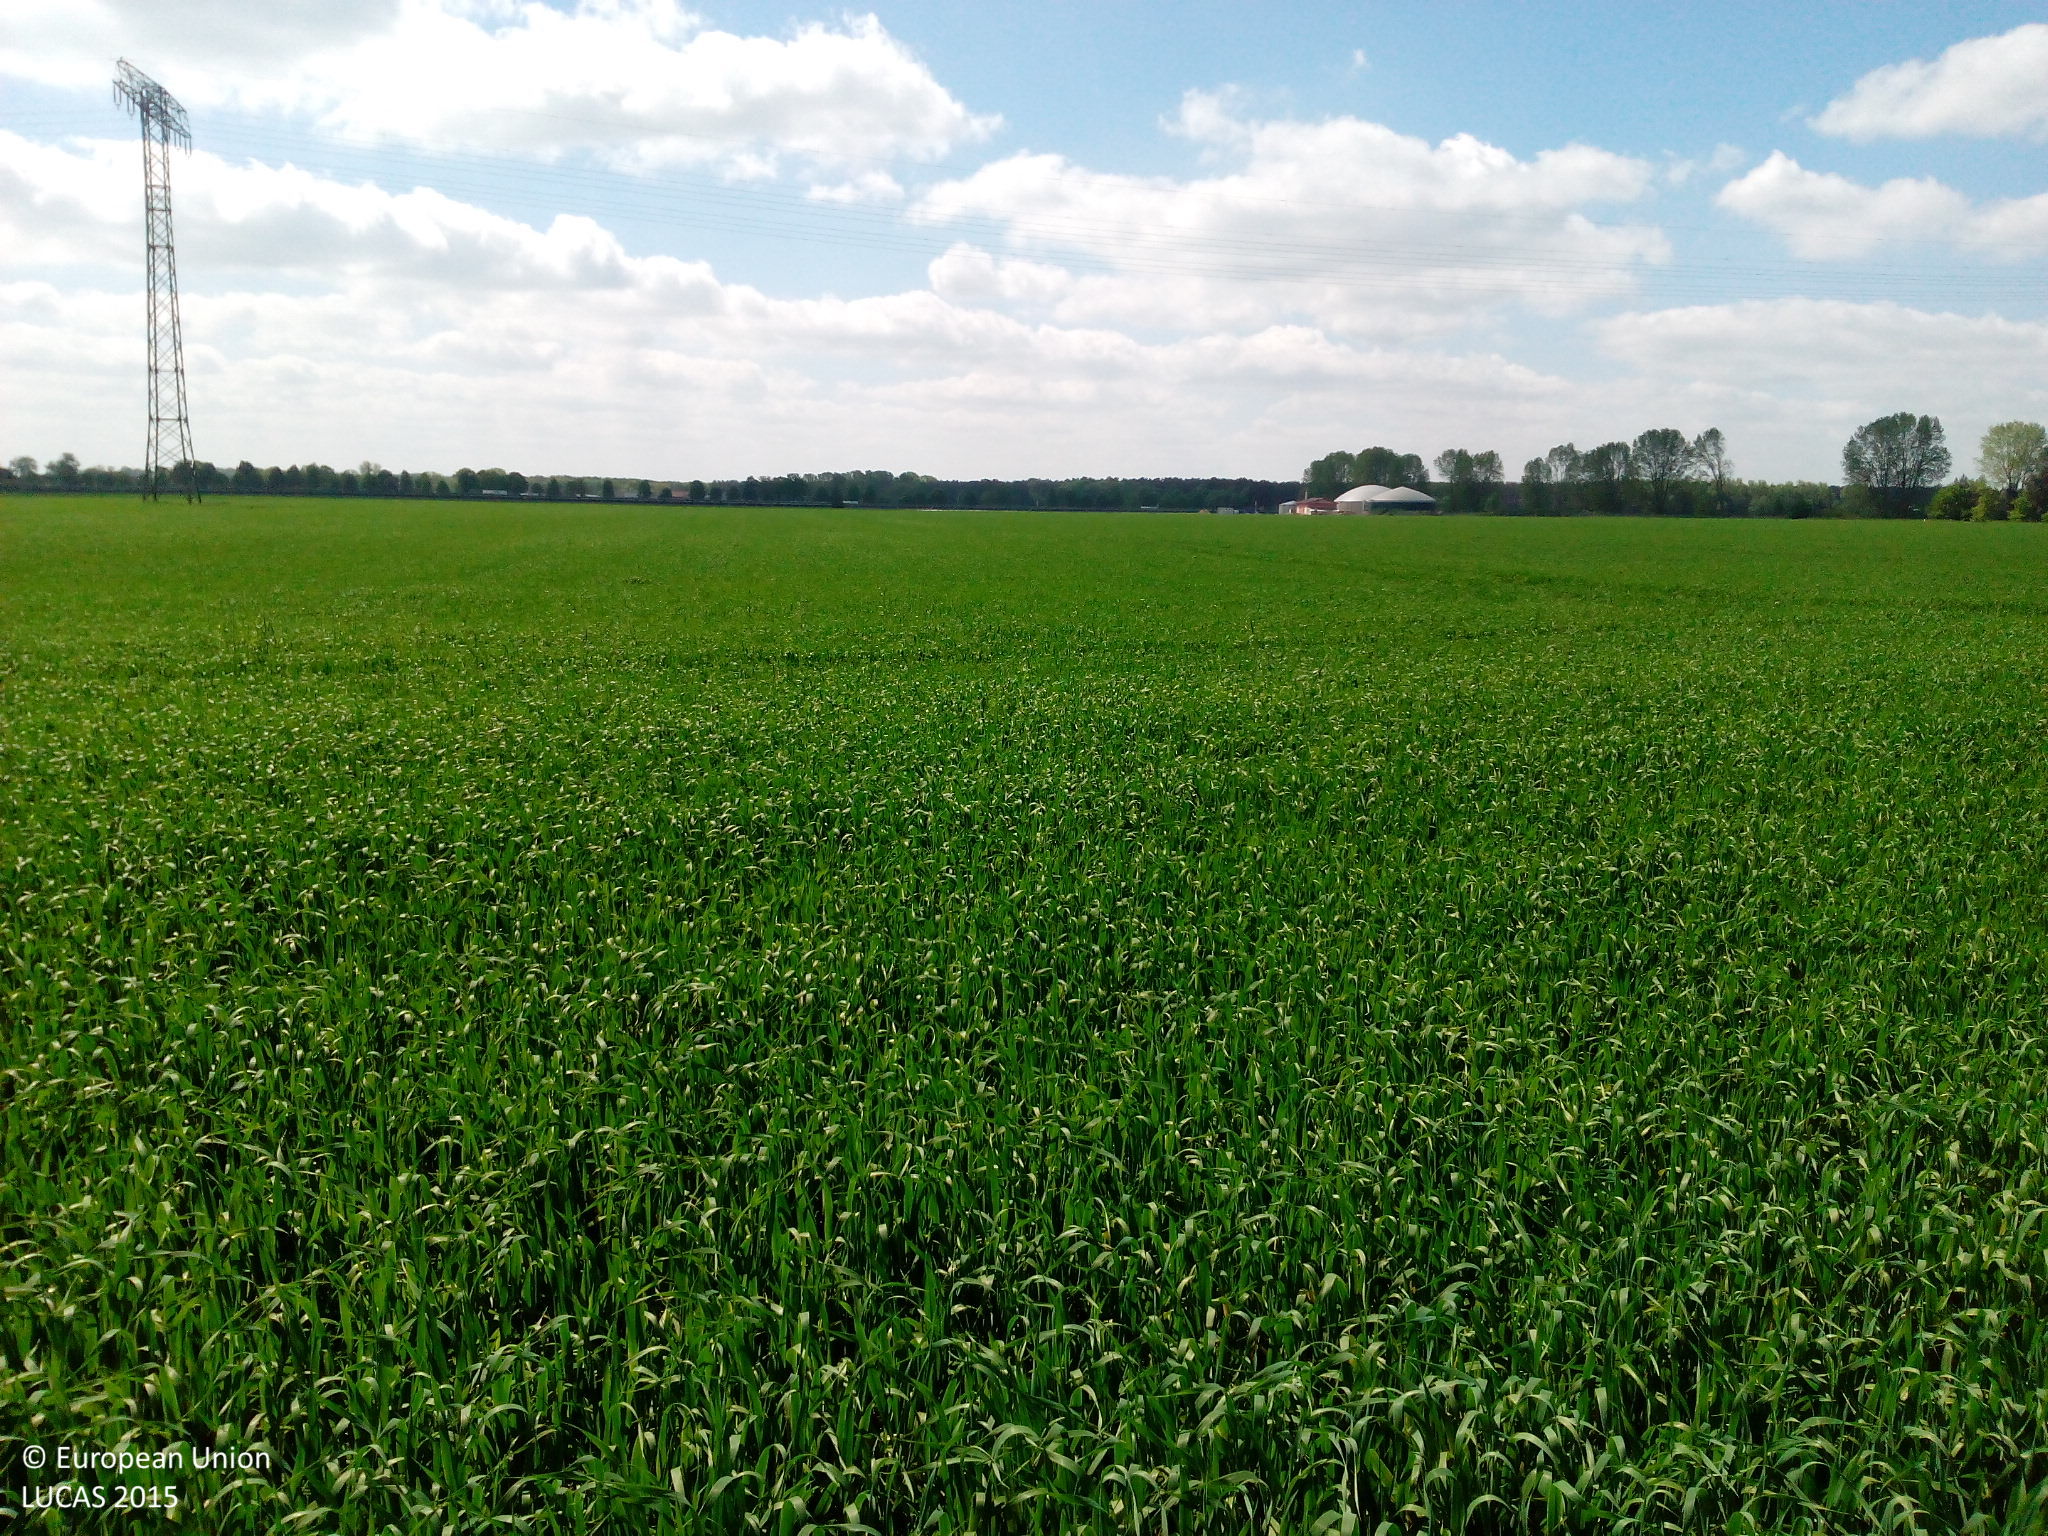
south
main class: Cropland
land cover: Oats
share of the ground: > 75 %
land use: Agriculture (excluding fallow land and kitchen gardens)
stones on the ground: < 10 %
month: May
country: DE
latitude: 53.3909
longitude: 11.6384
